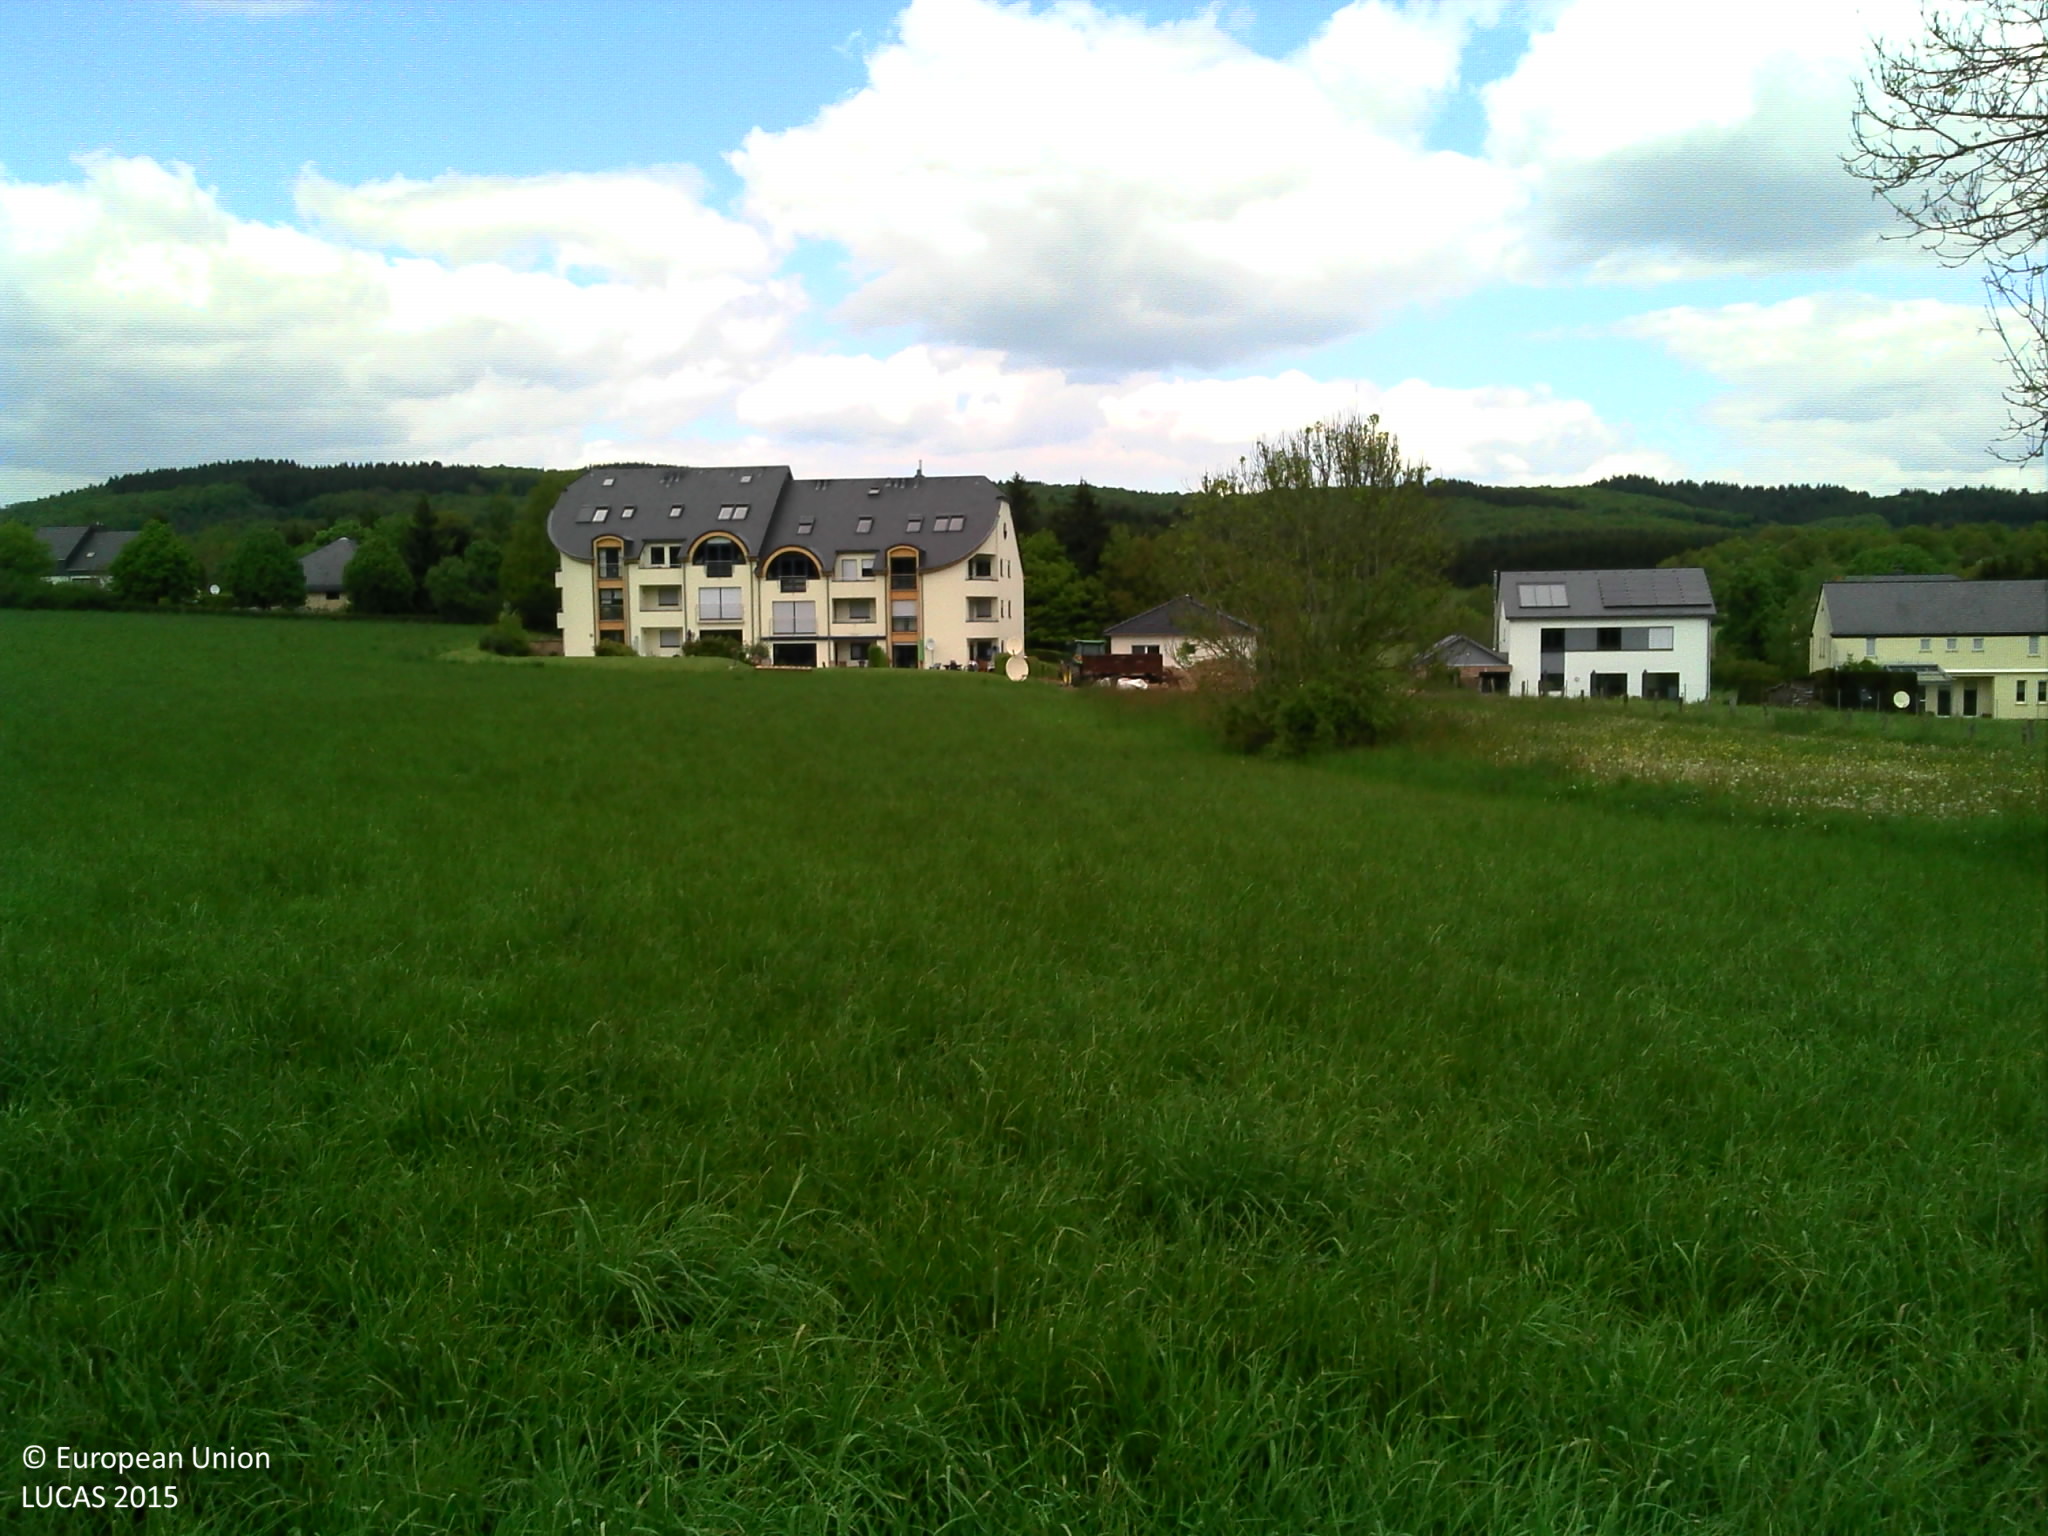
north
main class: Grassland
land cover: Grassland without tree/shrub cover
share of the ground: > 75 %
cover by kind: herbaceous plants 100 %
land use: Agriculture (excluding fallow land and kitchen gardens)
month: May
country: LU
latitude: 49.9660
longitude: 5.8863
